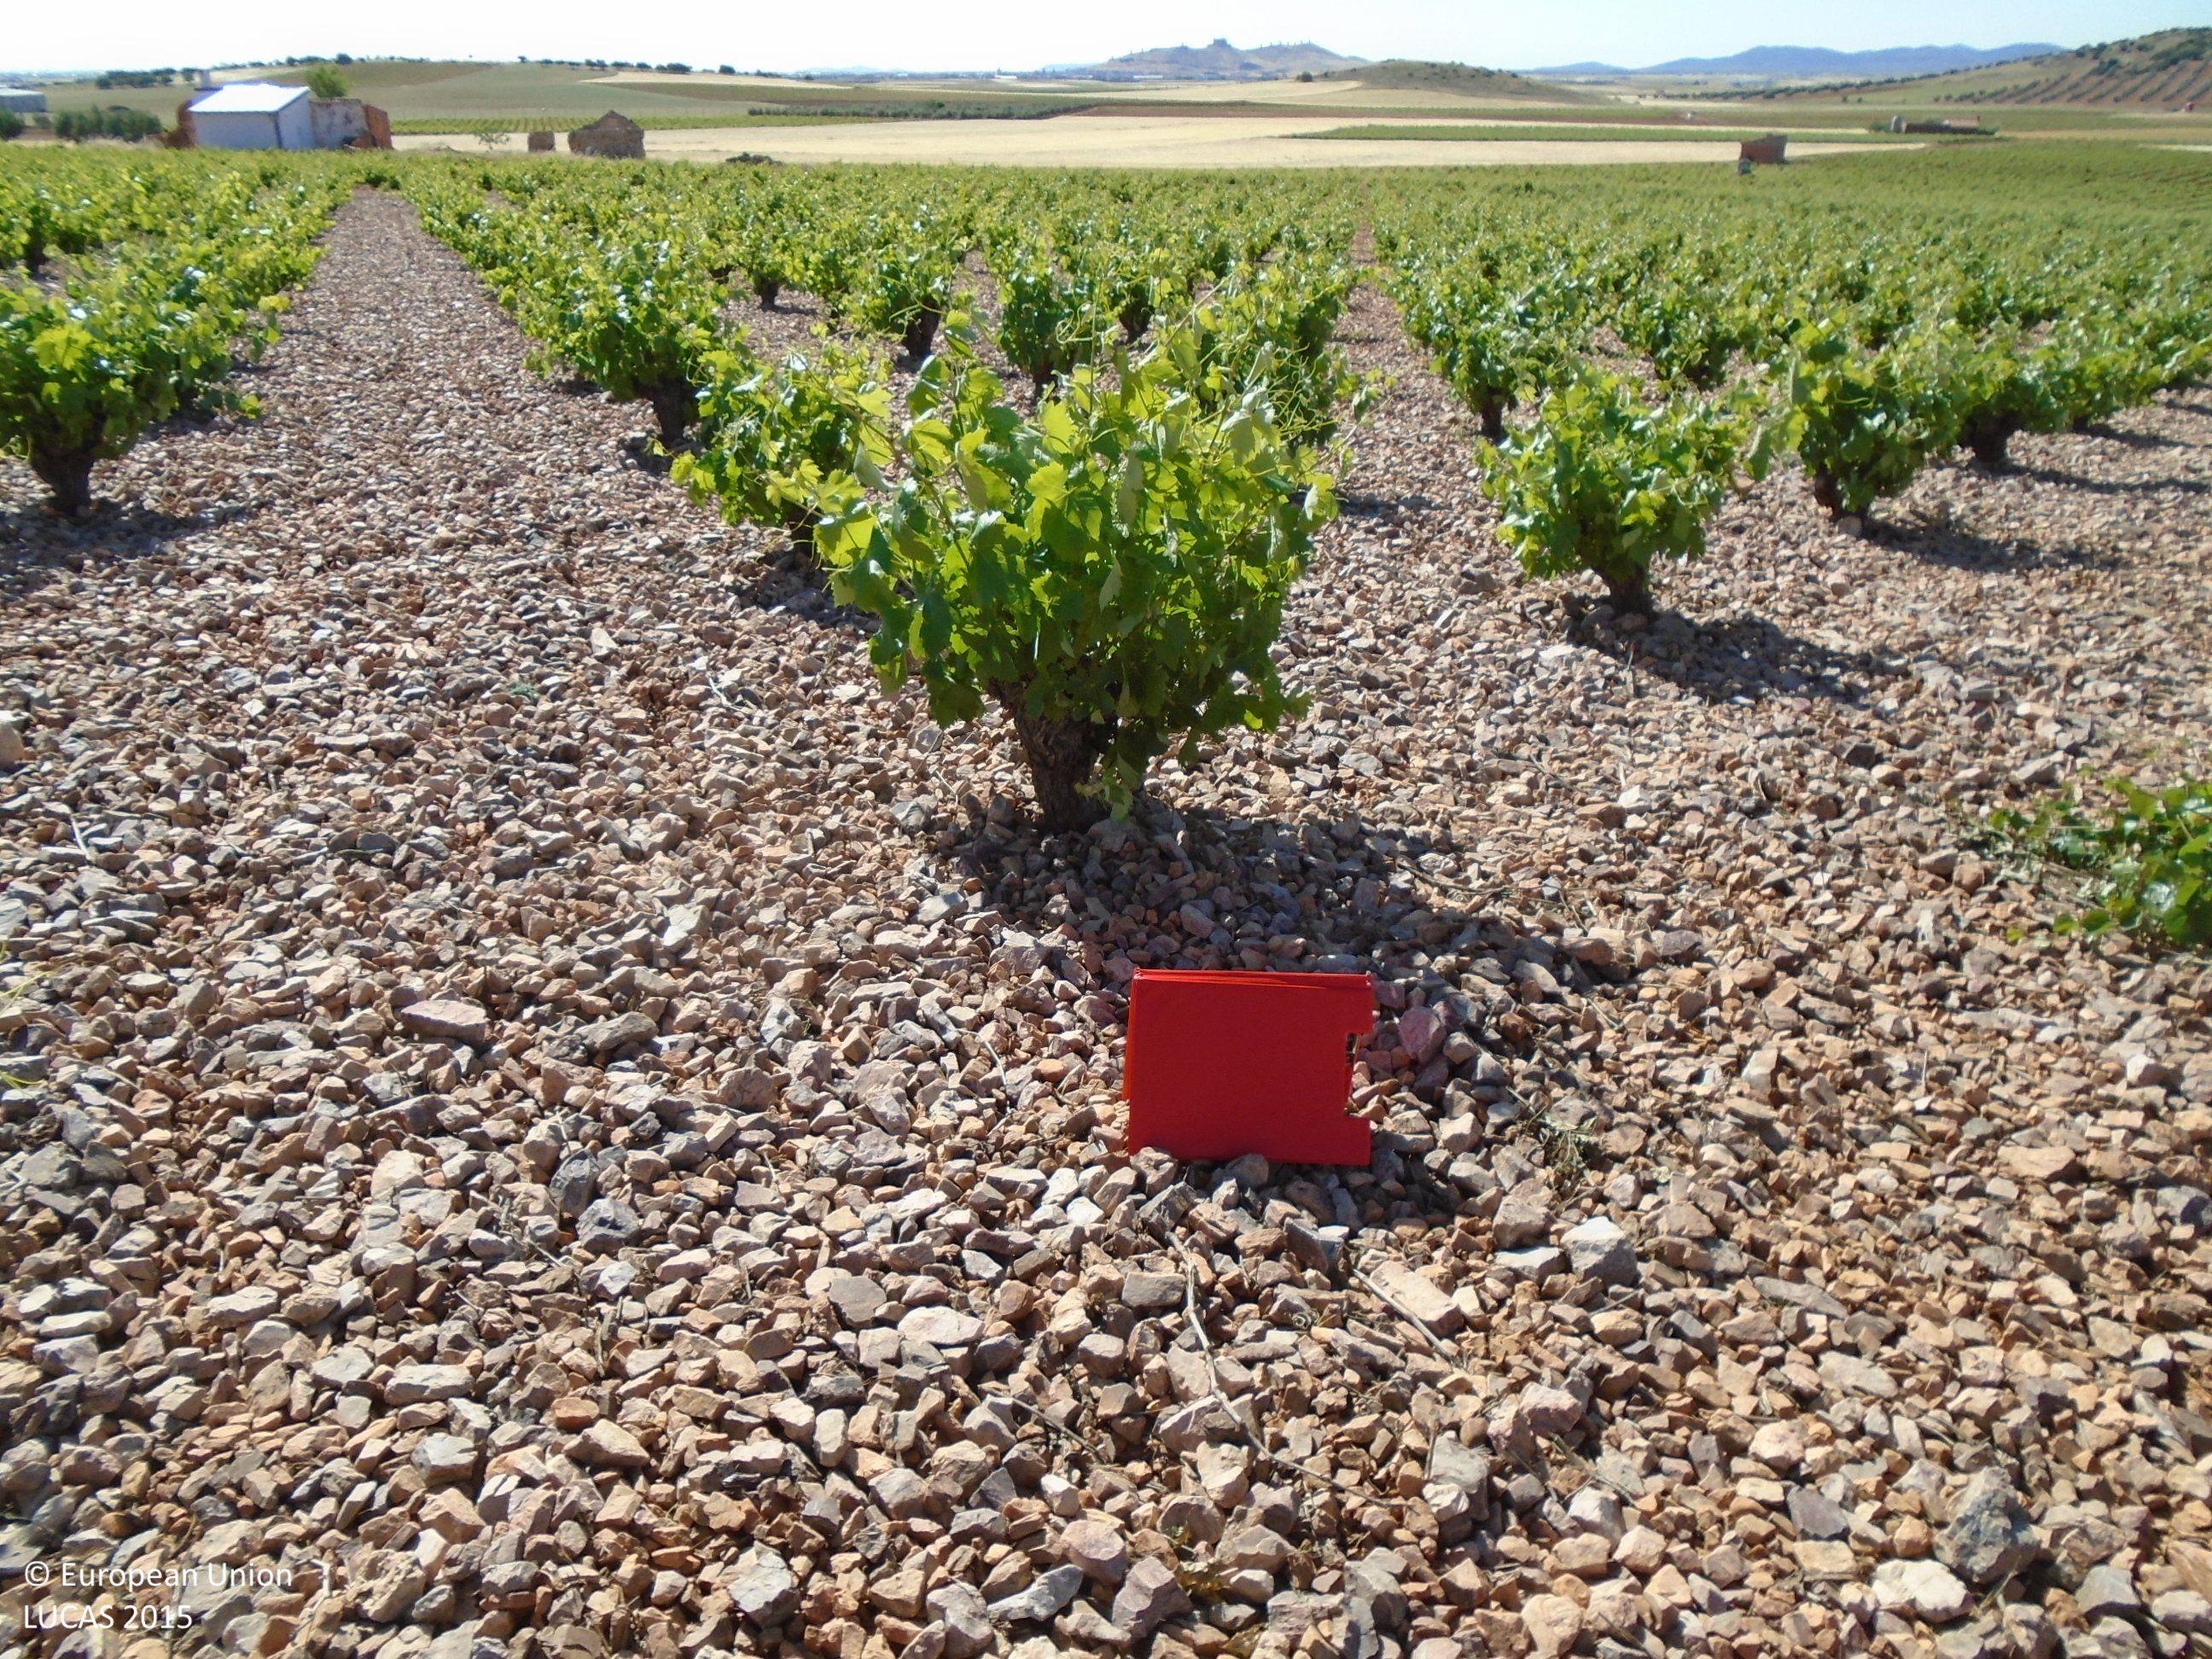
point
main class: Cropland
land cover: Vineyards
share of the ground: > 75 %
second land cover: Other bare soil
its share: > 75 %
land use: Agriculture (excluding fallow land and kitchen gardens)
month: May
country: ES
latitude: 39.4897
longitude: -3.6632
